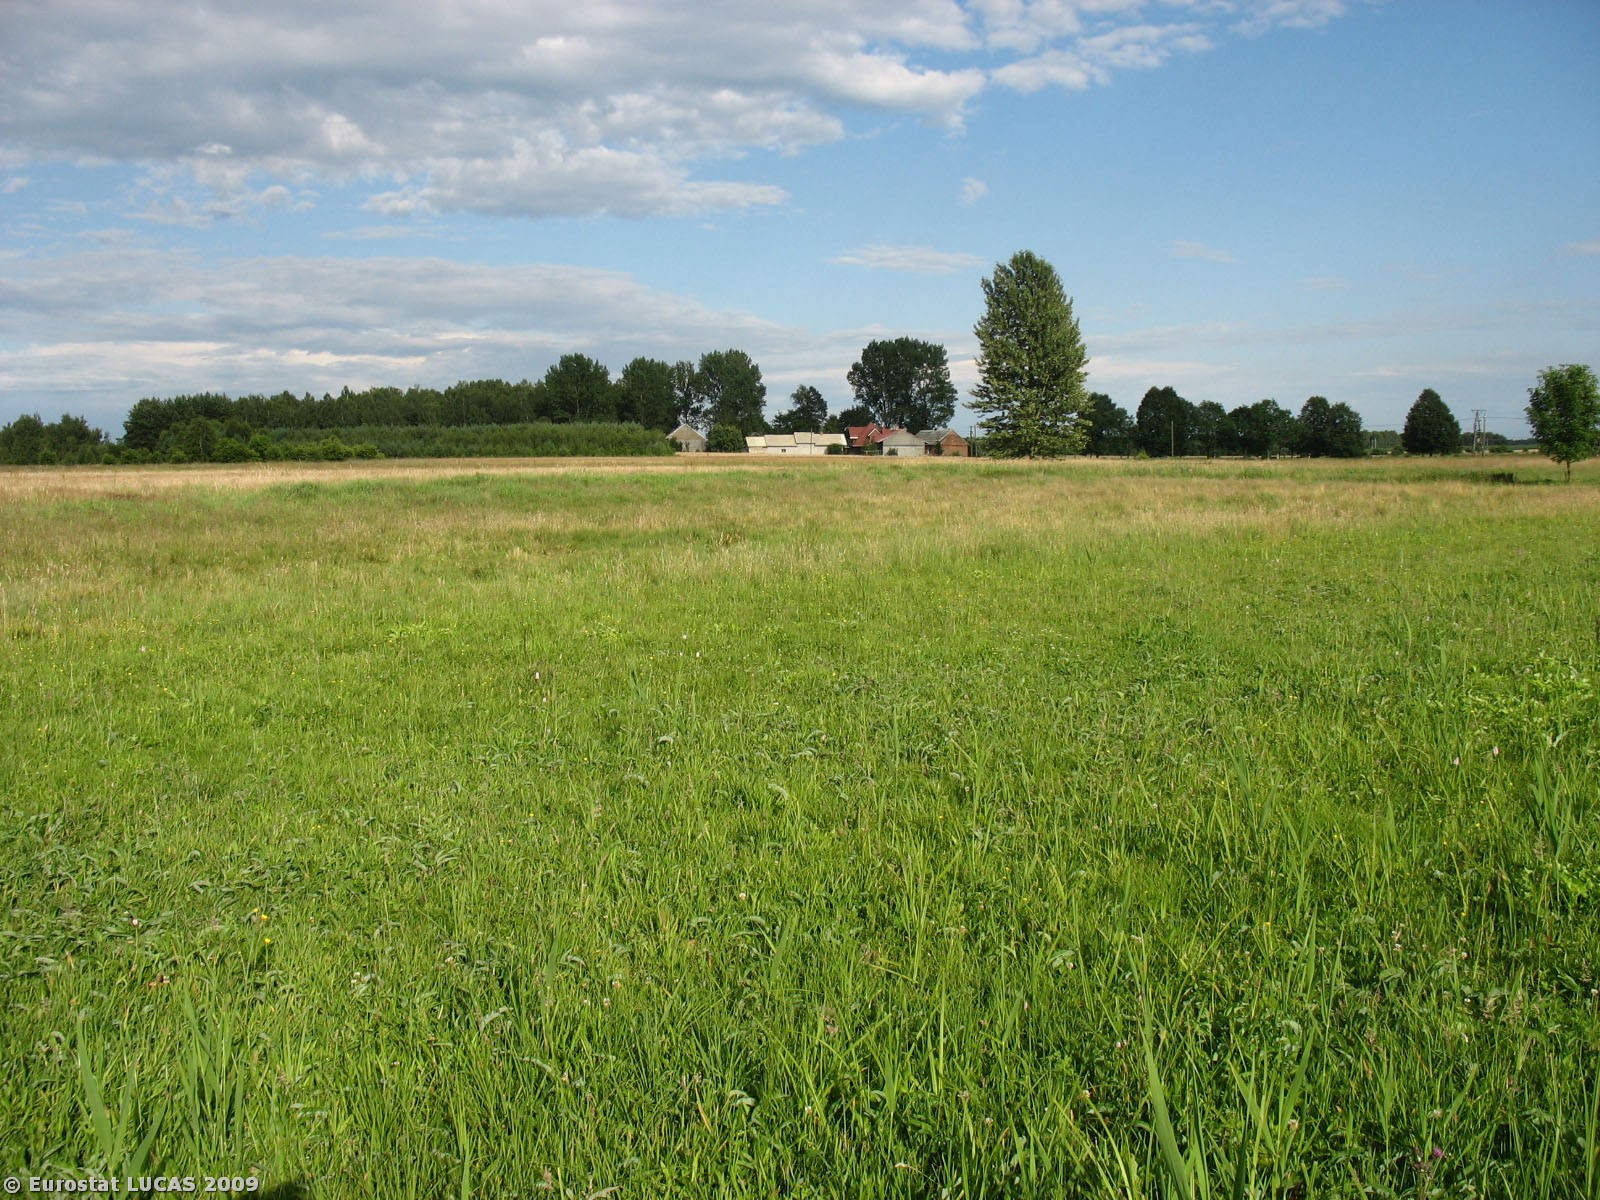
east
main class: Grassland
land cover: Grassland without tree/shrub cover
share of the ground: > 75 %
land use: Agriculture (excluding fallow land and kitchen gardens)
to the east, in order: Grassland without tree/shrub cover; Tracks; Grassland without tree/shrub cover; Grassland with sparse tree/shrub cover
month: July
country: PL
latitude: 50.7706
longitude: 19.8578
